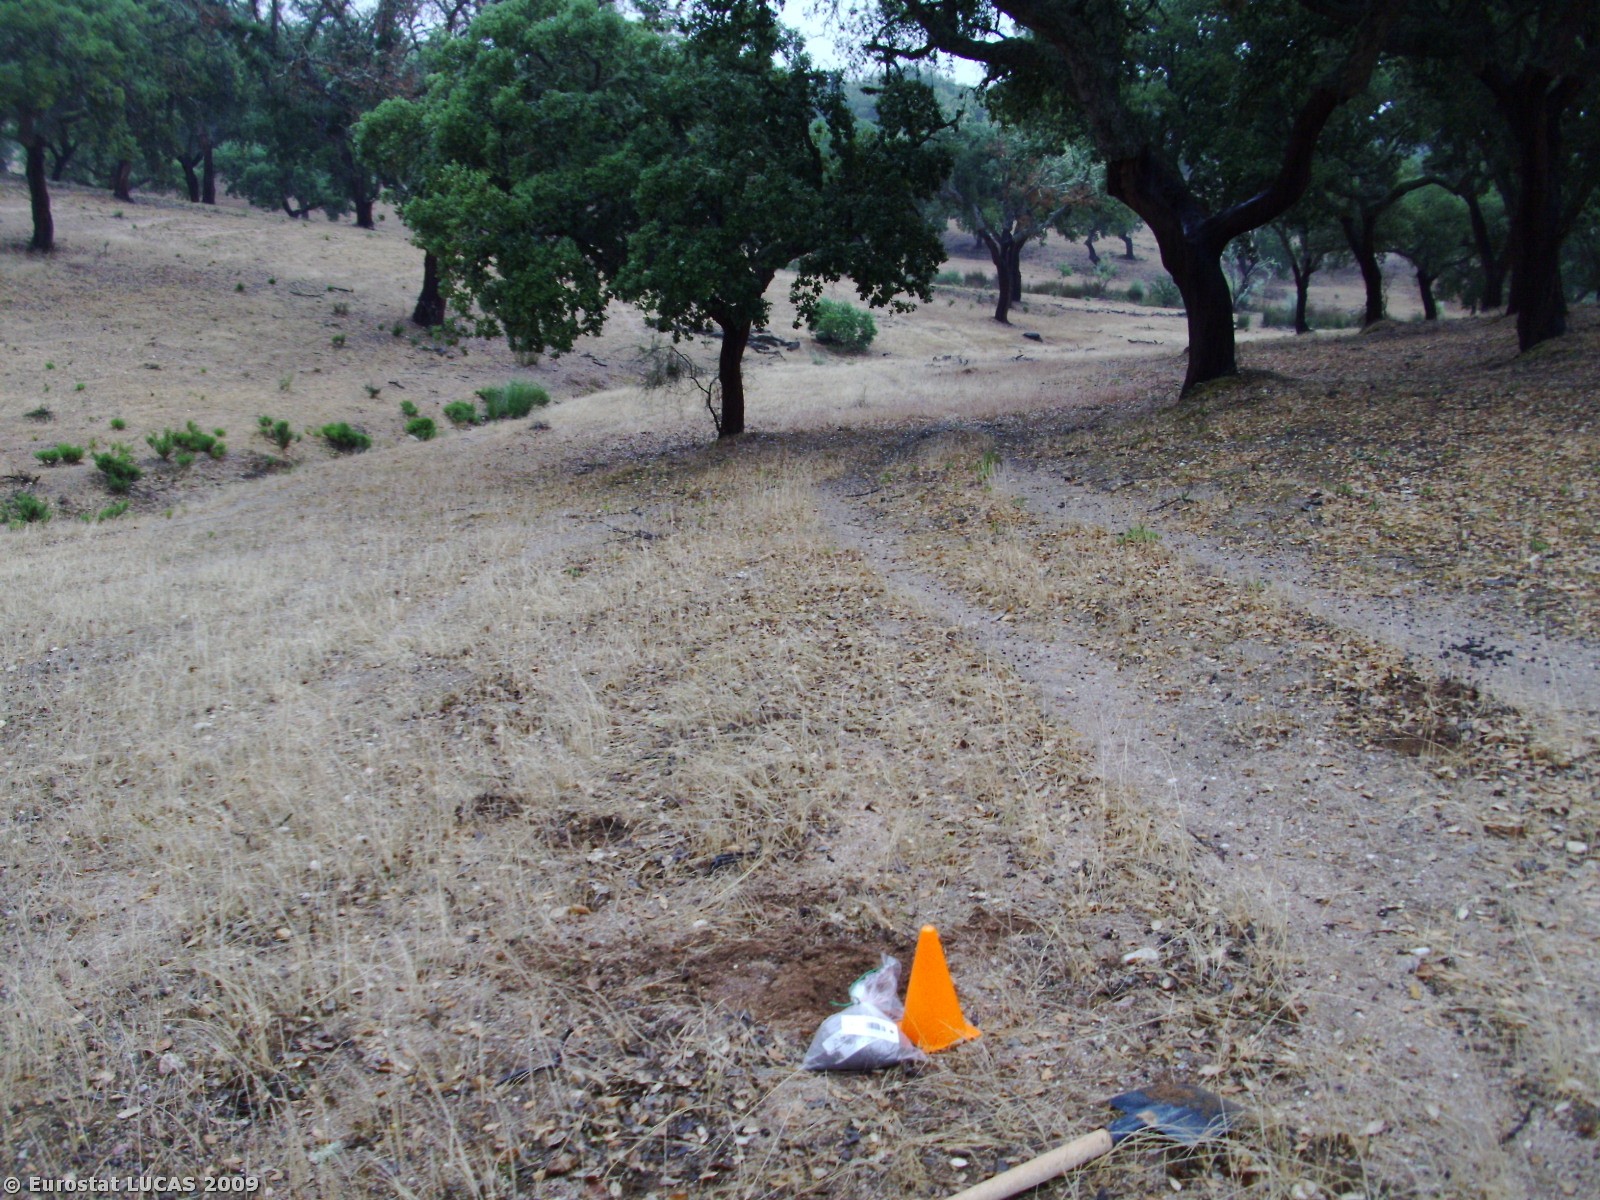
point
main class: Woodland
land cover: Broadleaved woodland
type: broadleaved evergreen forest
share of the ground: 50 - 75 %
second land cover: Bare land
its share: 25 - 50 %
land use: Forestry
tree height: > 5 m
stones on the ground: 25 - 50 %
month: June
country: PT
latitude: 39.7967
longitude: -7.2487
